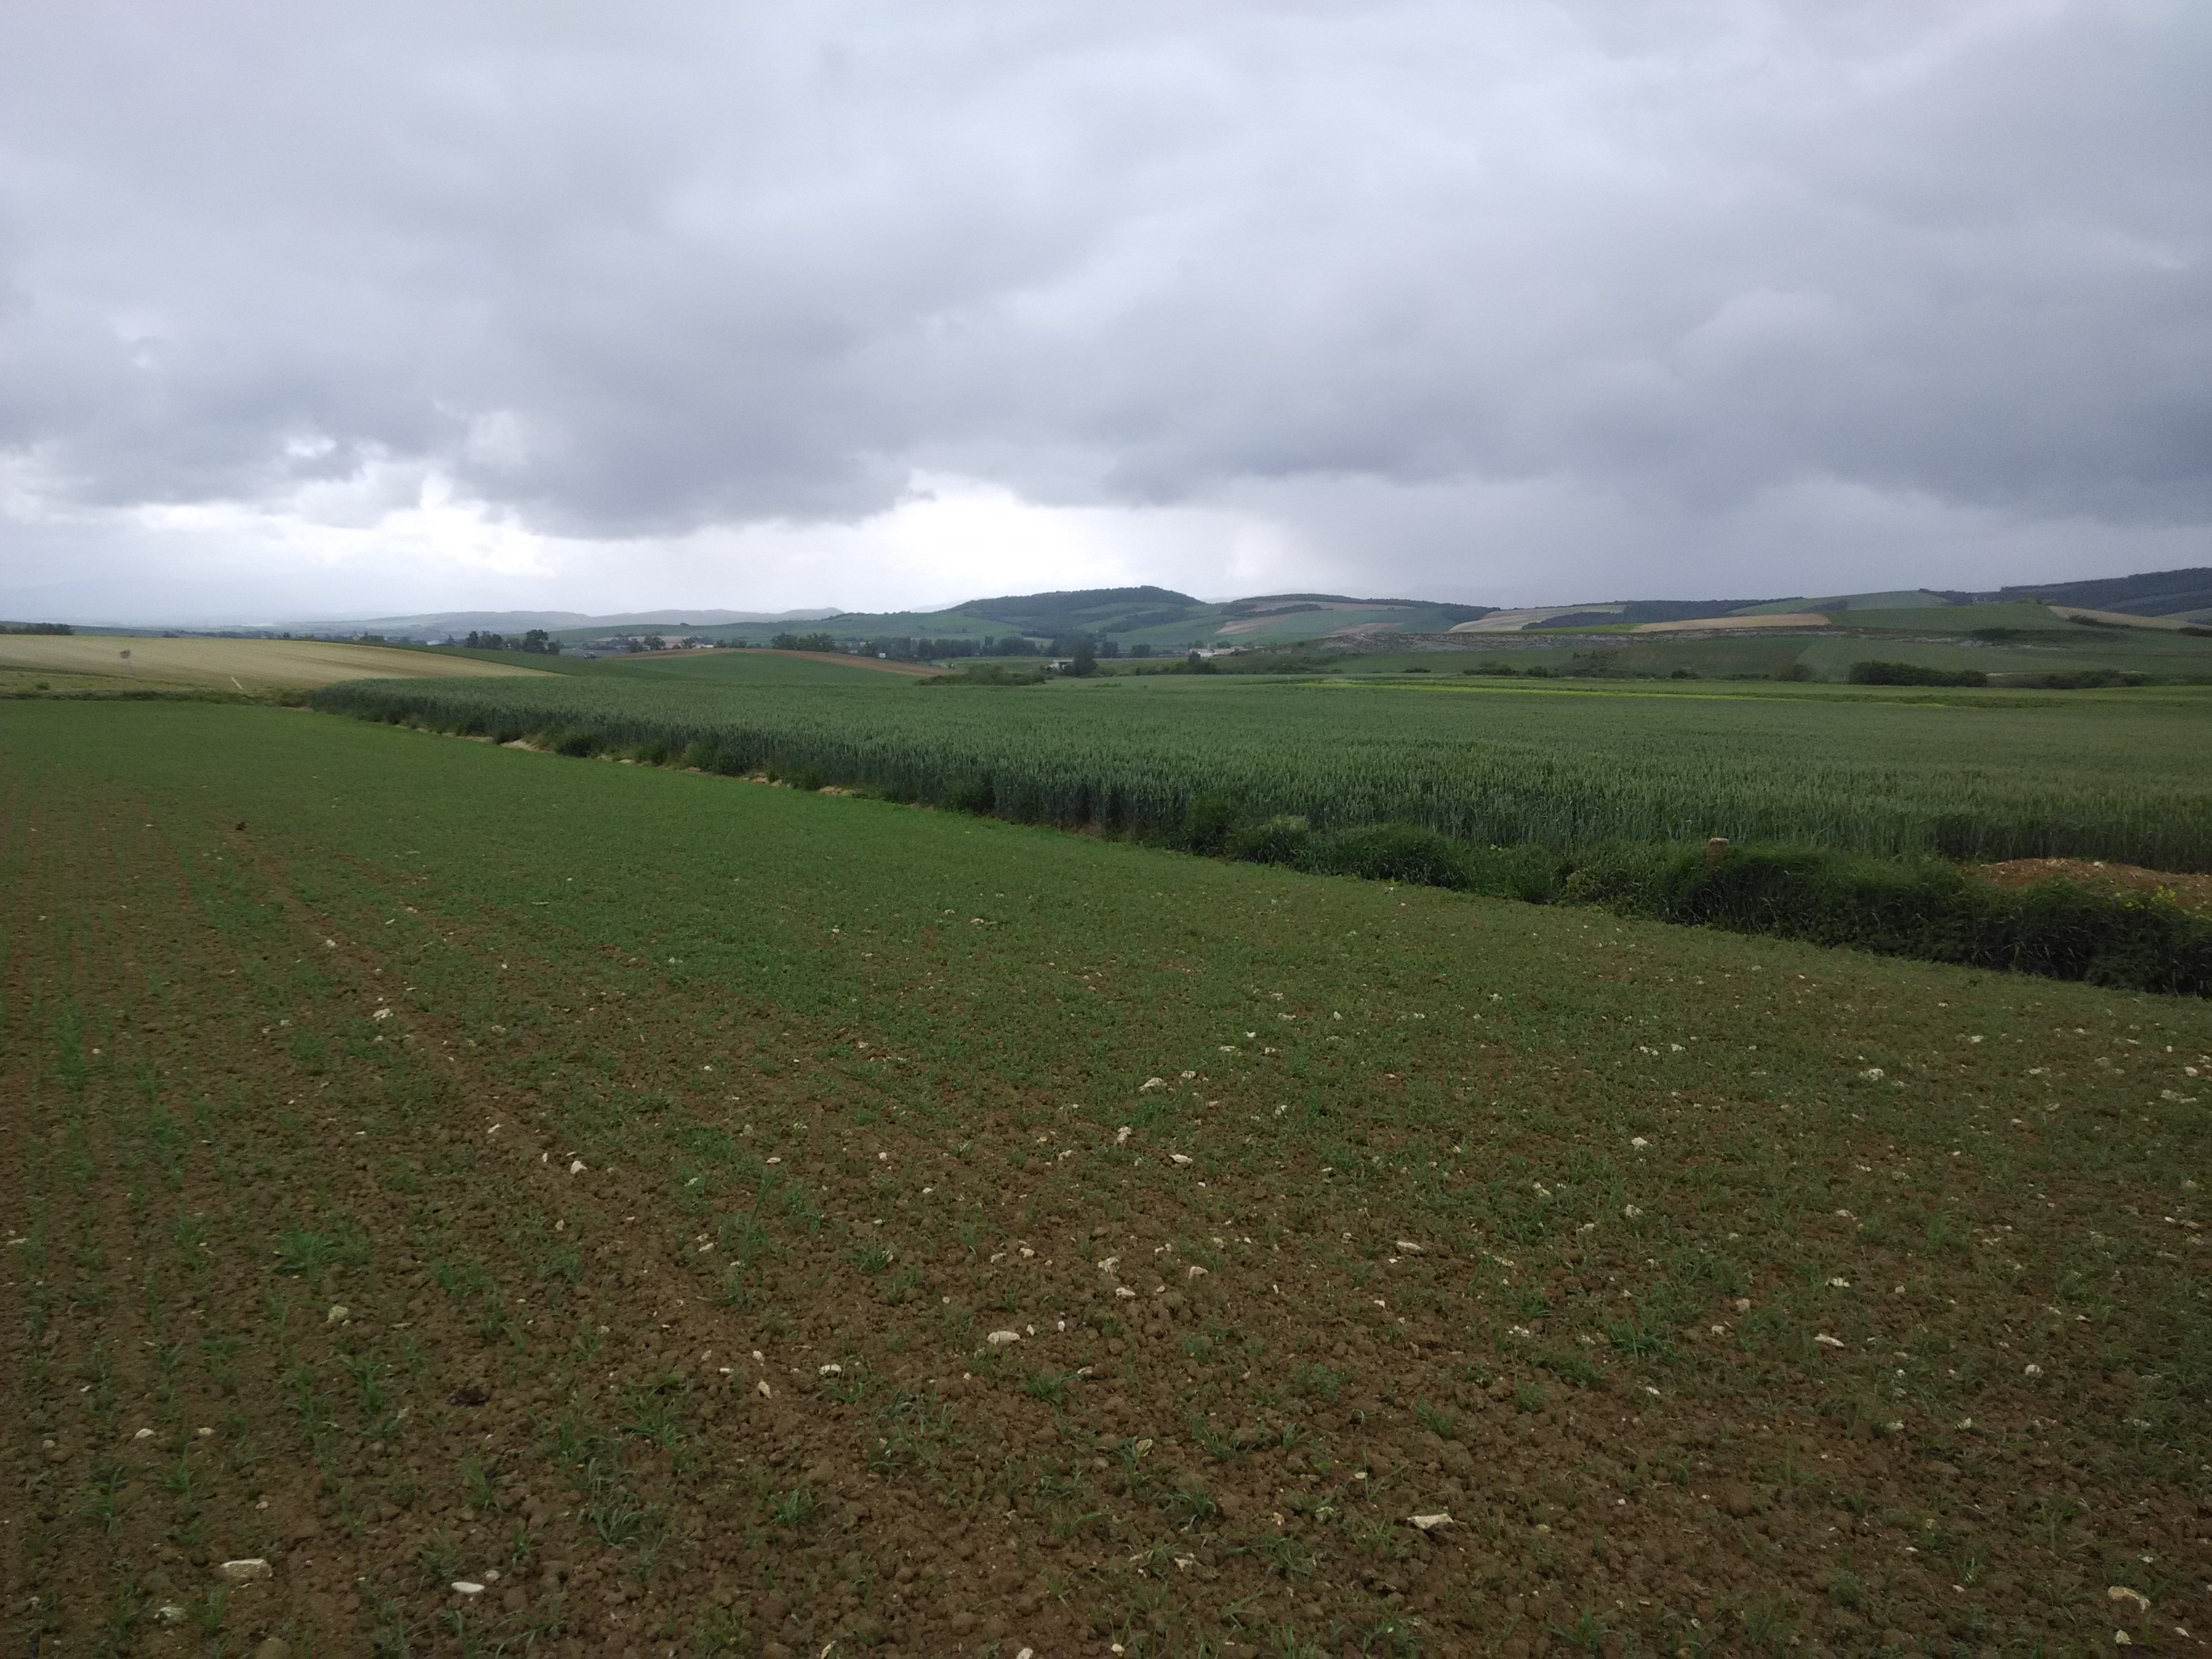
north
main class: Cropland
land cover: Mixed cereals for fodder
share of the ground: 10 - 25 %
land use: Agriculture (excluding fallow land and kitchen gardens)
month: May
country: ES
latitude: 42.8237
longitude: -2.5133
